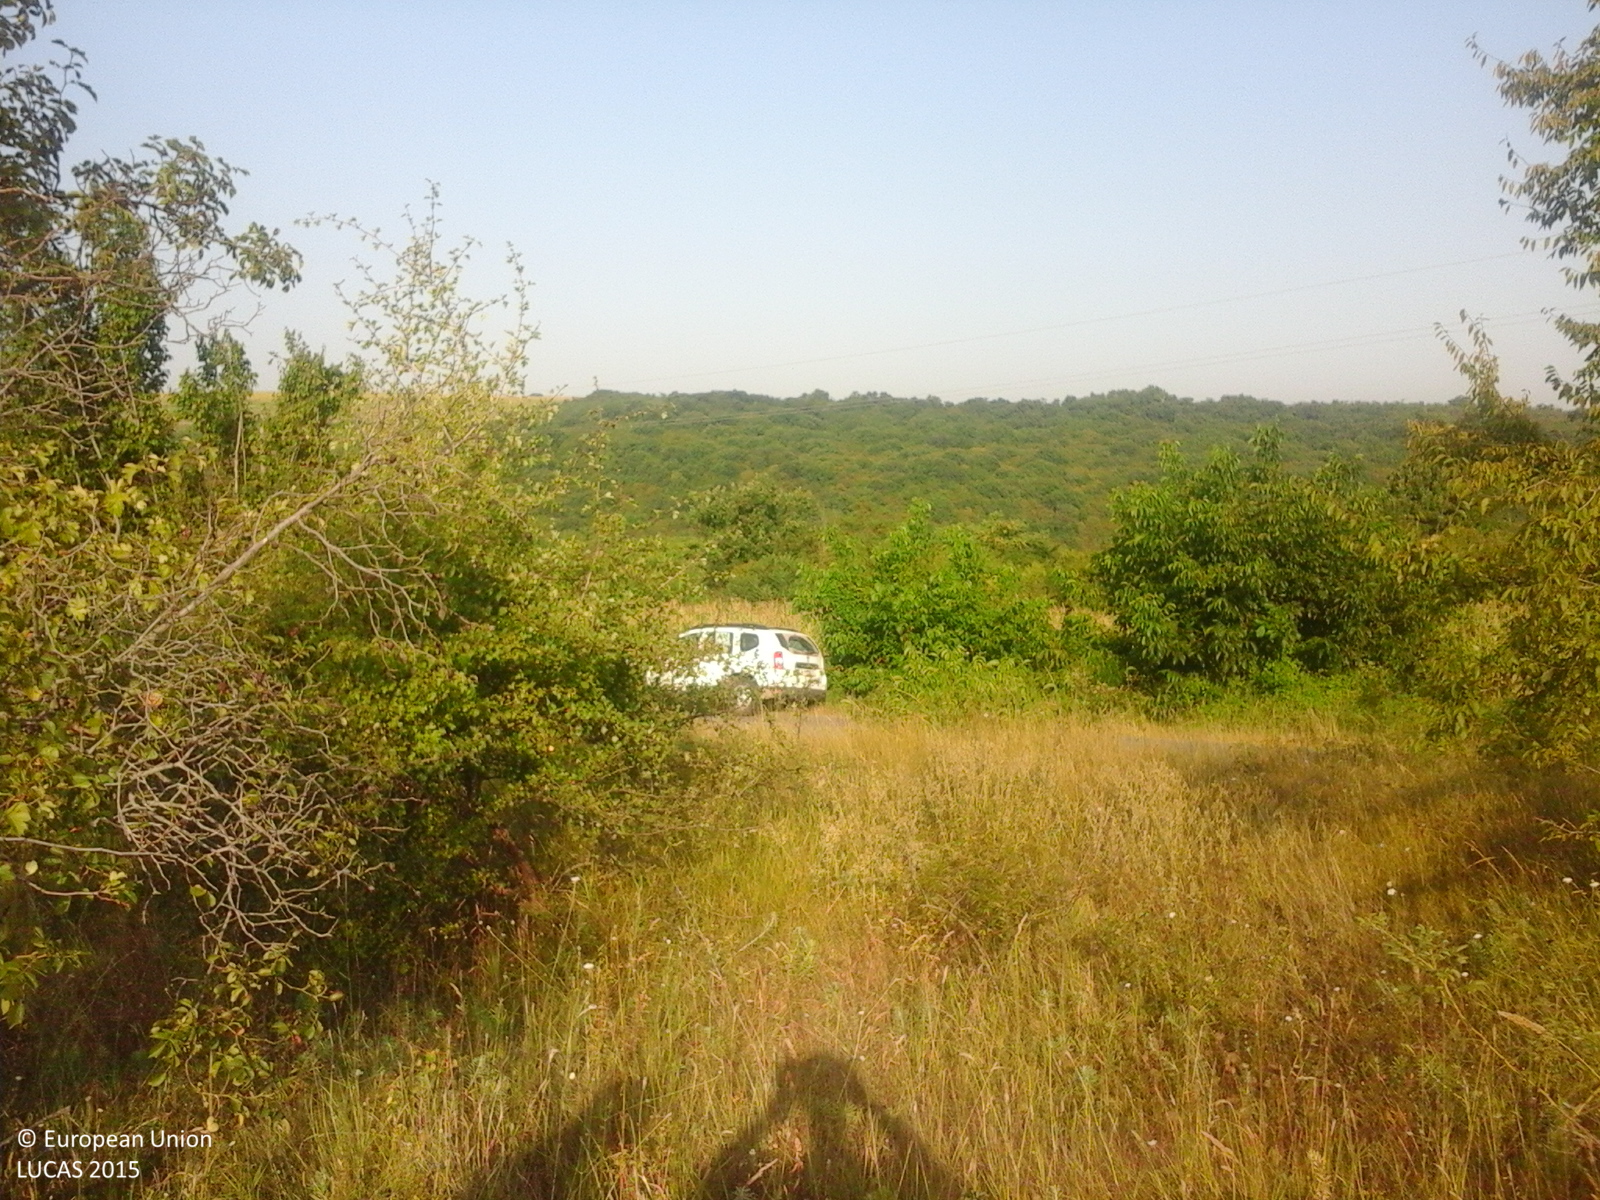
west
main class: Grassland
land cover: Grassland with sparse tree/shrub cover
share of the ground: > 75 %
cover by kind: herbaceous plants 95 %, broadleaved forest trees 5 %
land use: Semi-natural and natural areas not in use
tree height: > 5 m
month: August
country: RO
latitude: 44.0579
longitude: 27.9648
